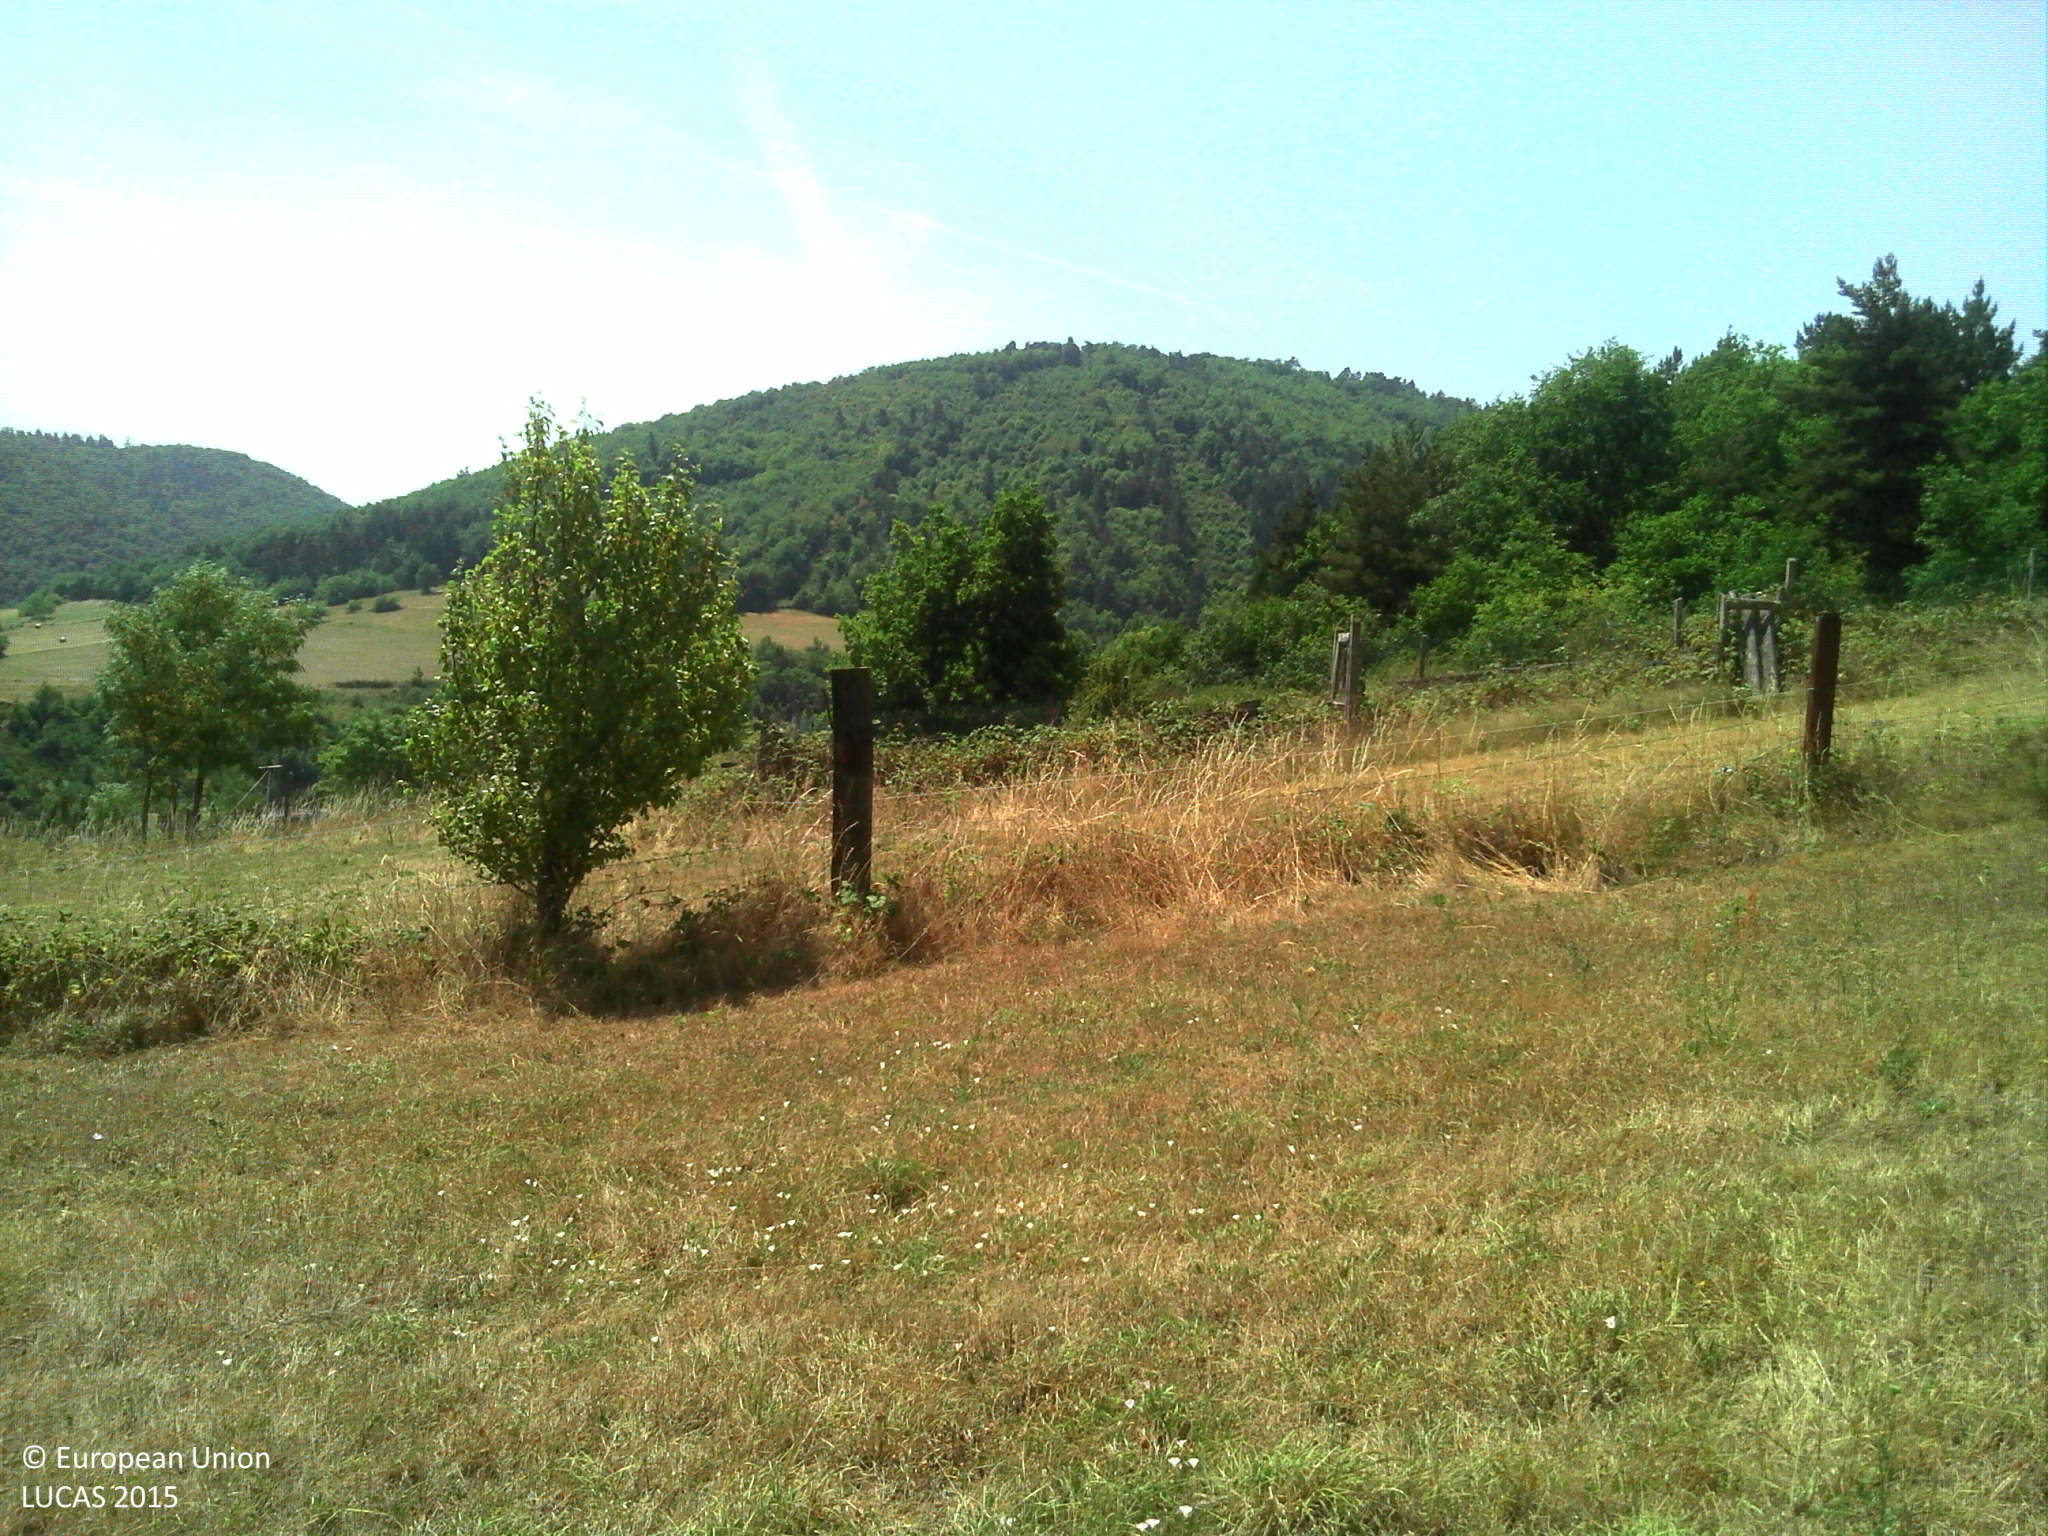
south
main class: Grassland
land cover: Grassland without tree/shrub cover
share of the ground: > 75 %
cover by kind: herbaceous plants 100 %
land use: Agriculture (excluding fallow land and kitchen gardens)
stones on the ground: < 10 %
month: July
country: FR
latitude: 45.3393
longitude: 3.1997
